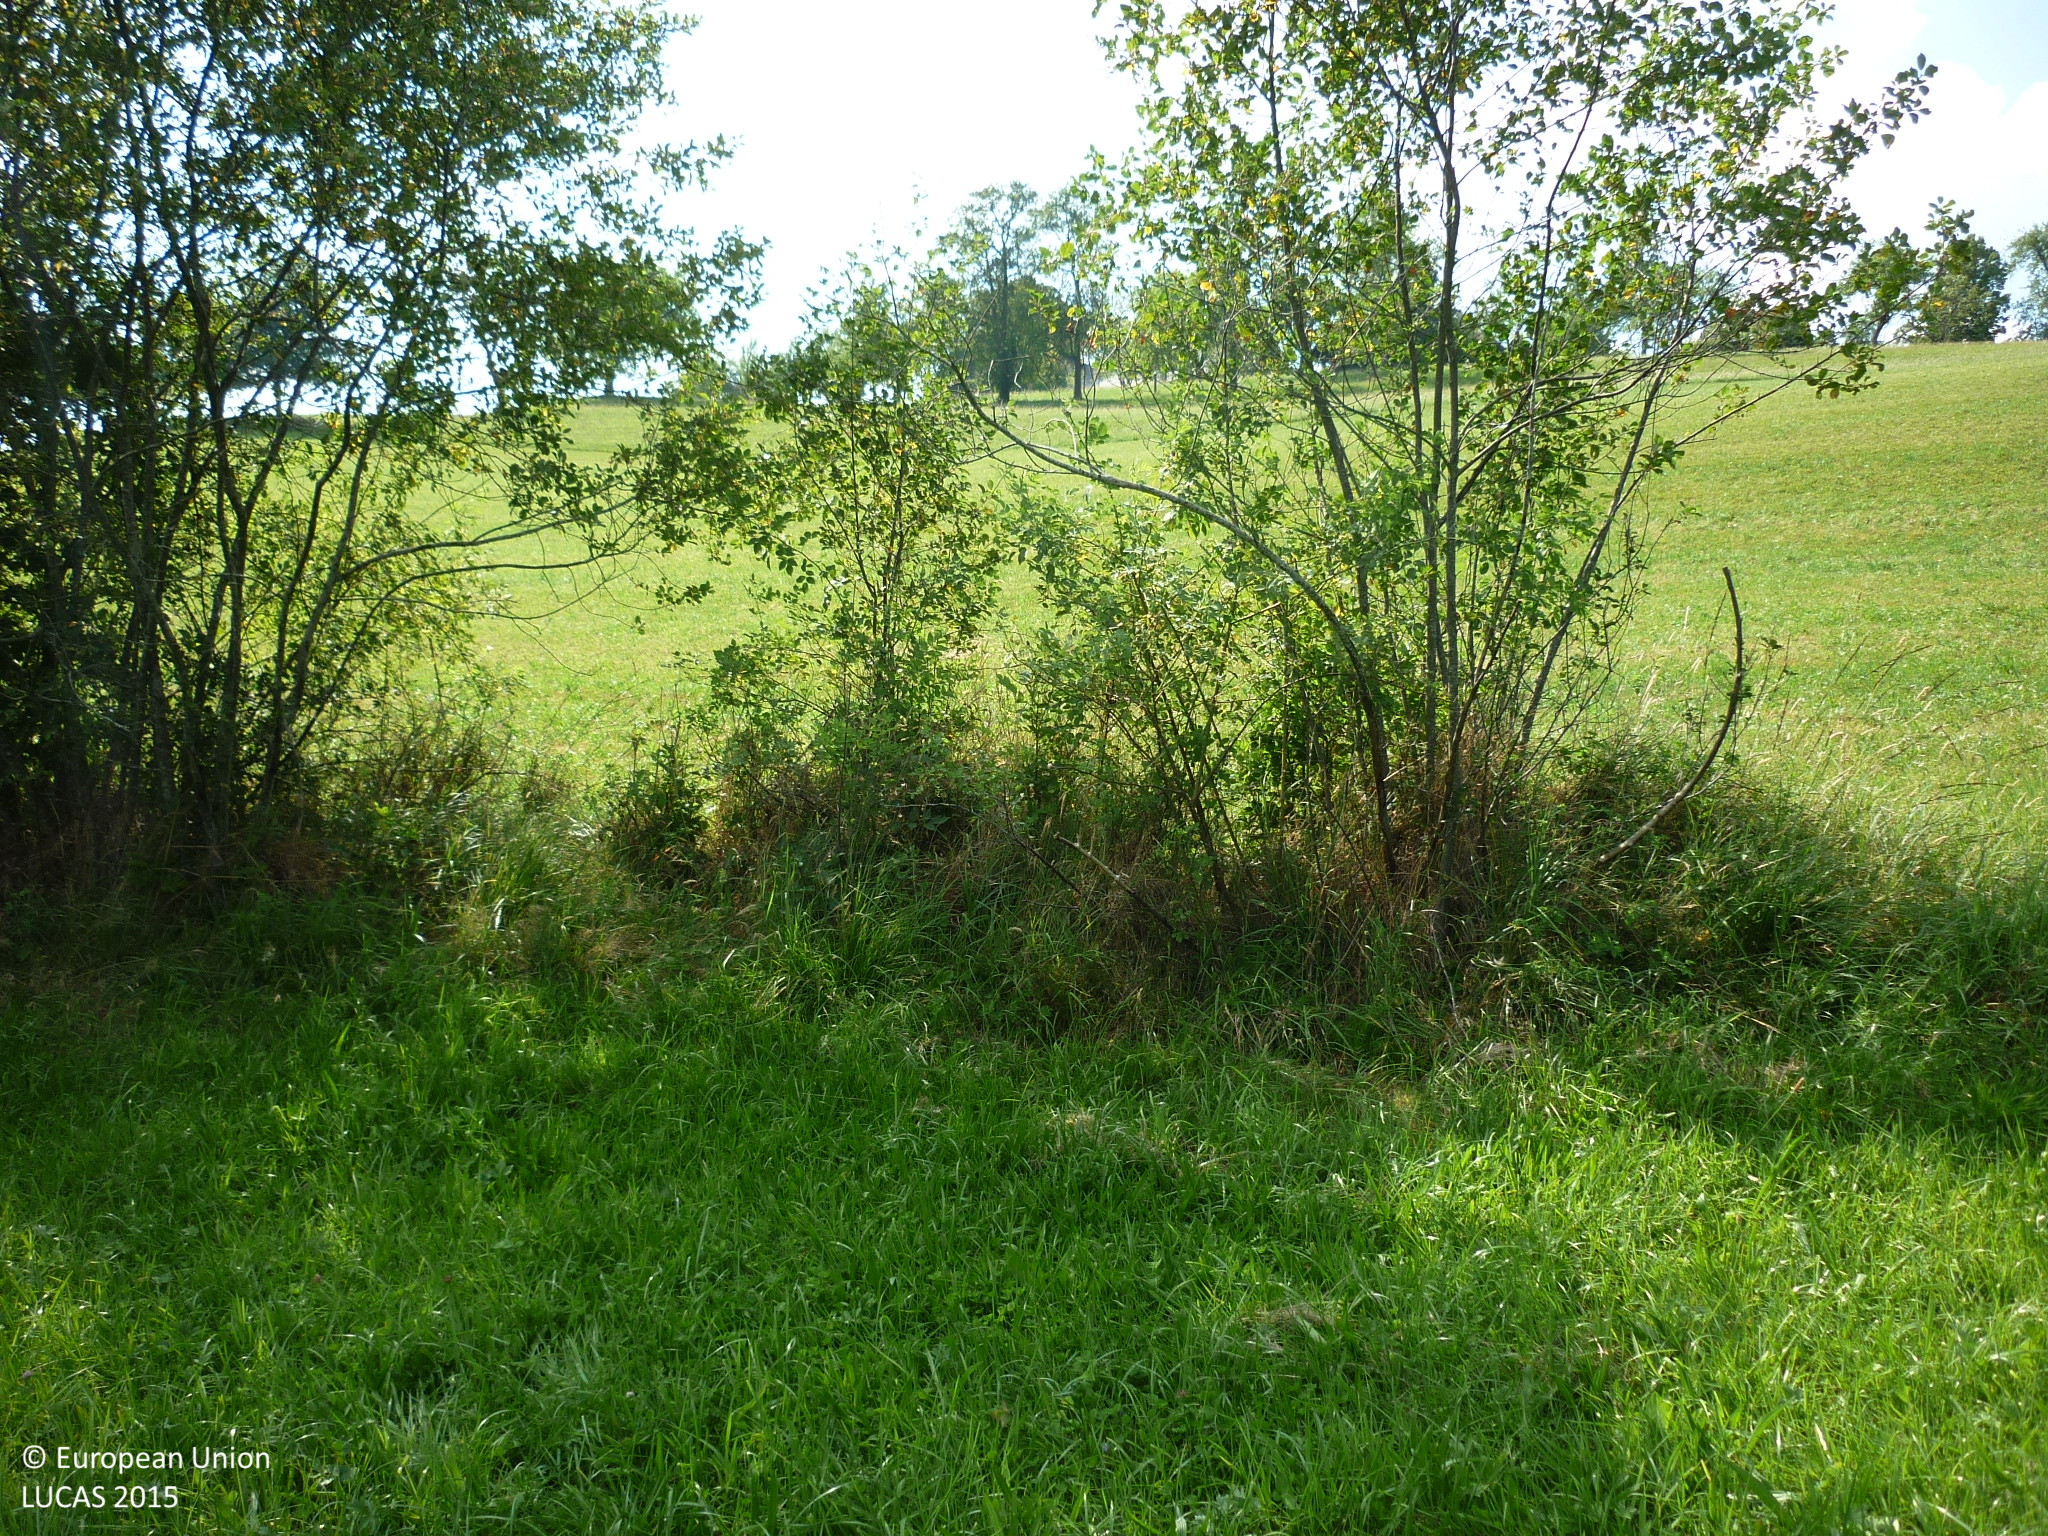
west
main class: Grassland
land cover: Grassland without tree/shrub cover
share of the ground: > 75 %
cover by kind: herbaceous plants 100 %
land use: Agriculture (excluding fallow land and kitchen gardens)
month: August
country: AT
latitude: 47.7112
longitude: 14.1977
